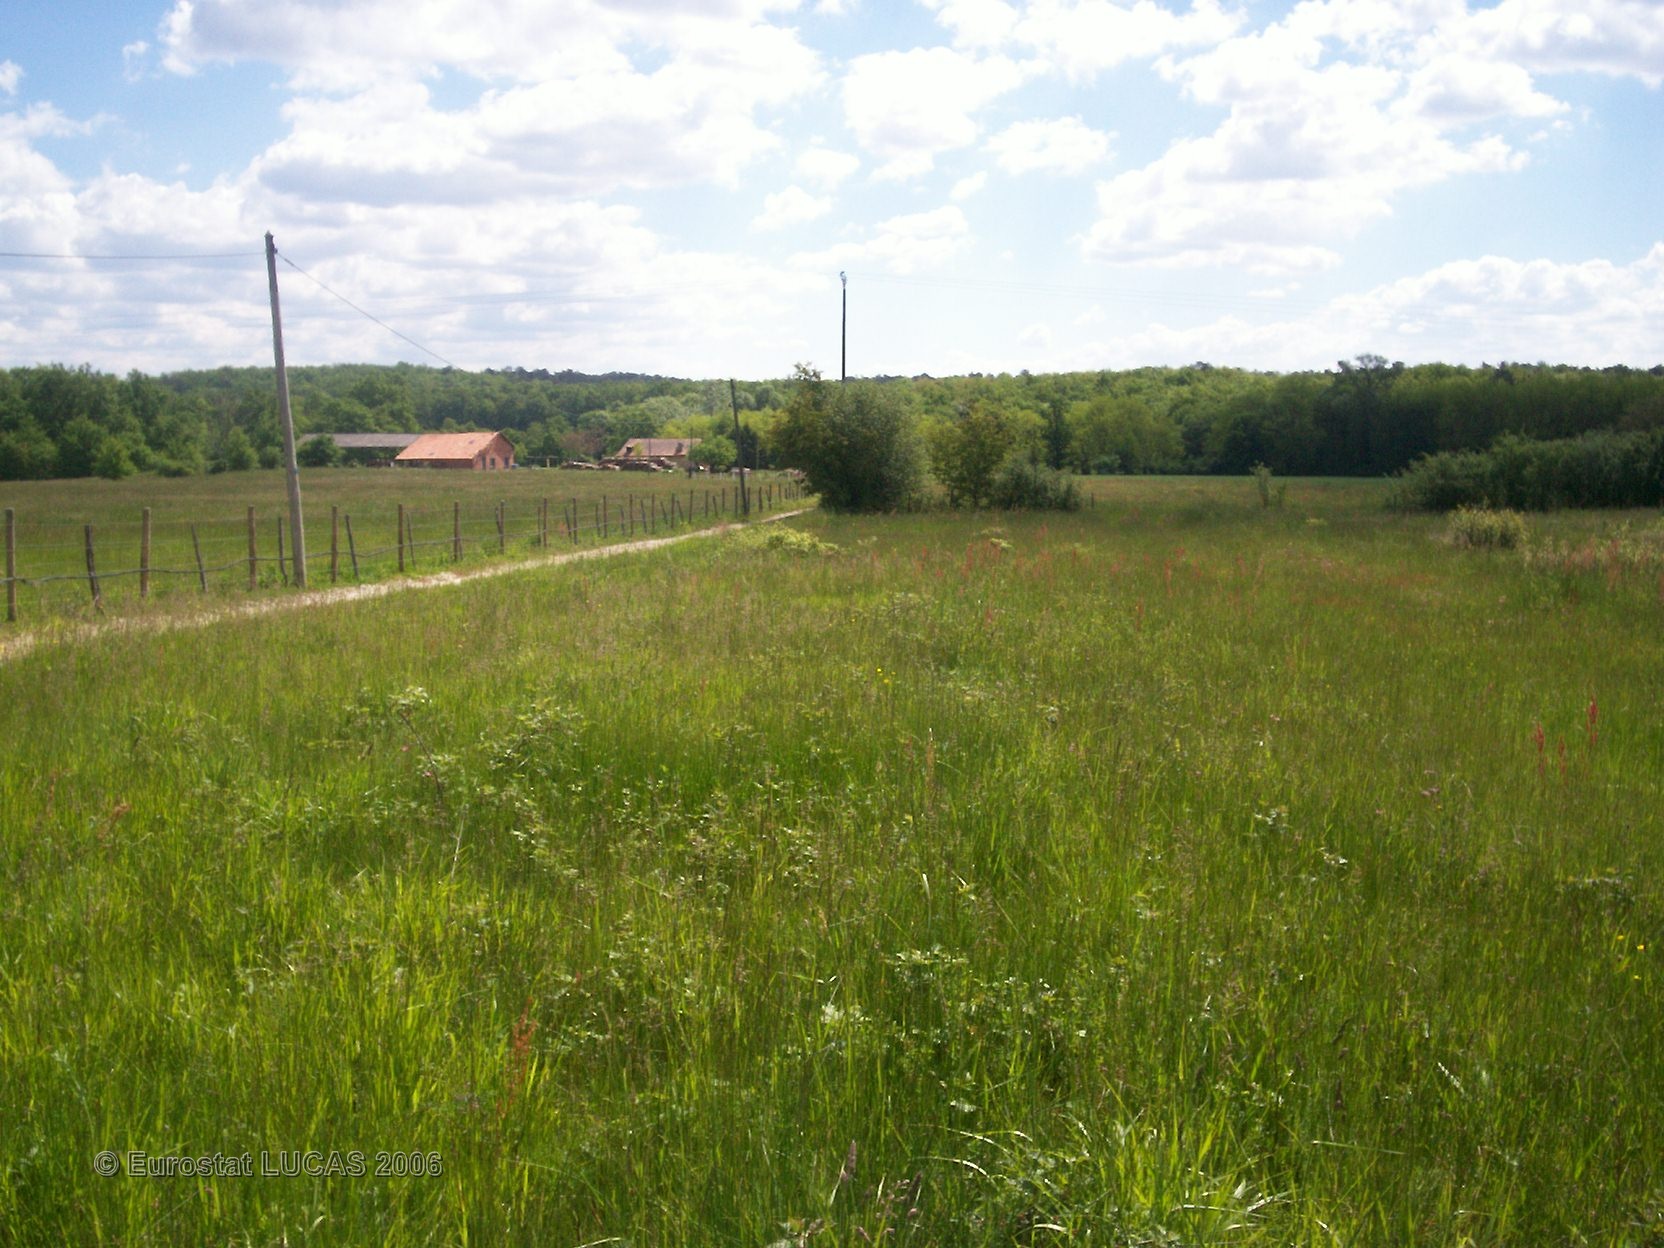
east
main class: Grassland
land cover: Grassland without tree/shrub cover
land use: Agriculture (excluding fallow land and kitchen gardens)
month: May
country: FR
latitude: 44.9033
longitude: 0.0193
